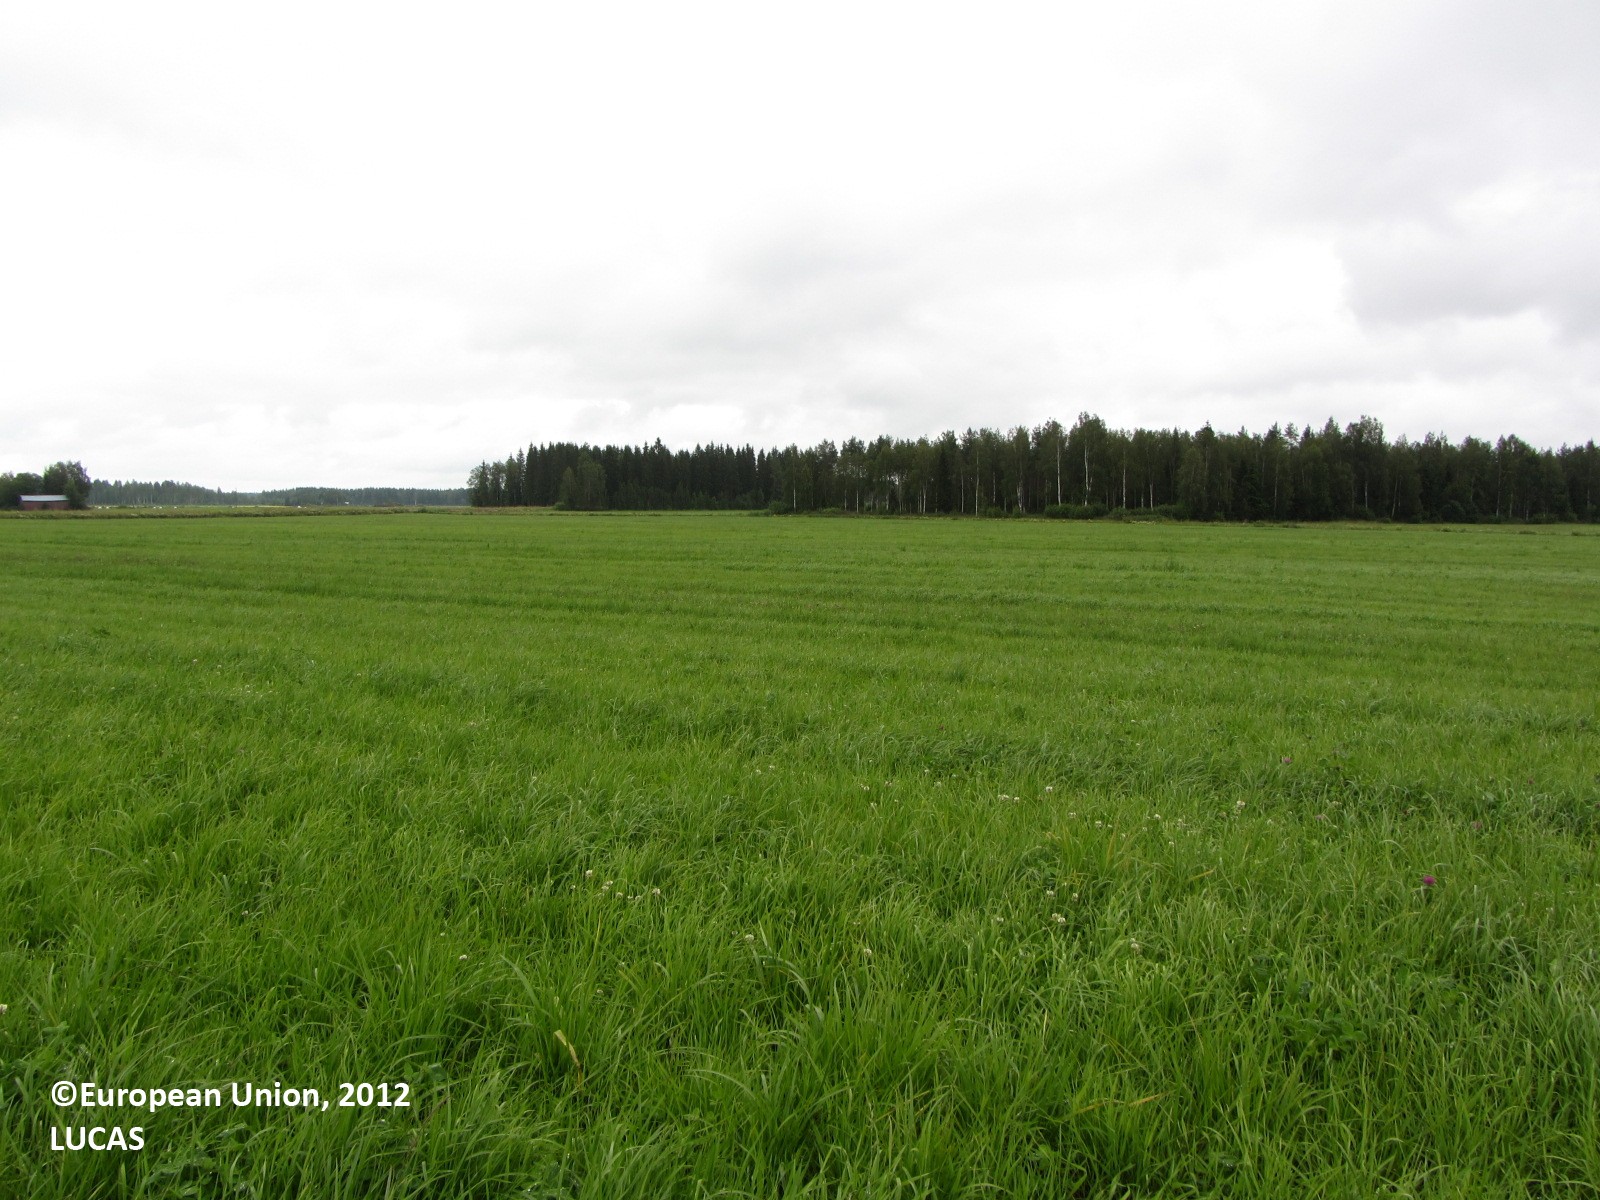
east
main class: Cropland
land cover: Temporary grasslands
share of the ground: > 75 %
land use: Agriculture (excluding fallow land and kitchen gardens)
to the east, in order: Temporary grasslands
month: July
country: FI
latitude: 63.9219
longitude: 24.7815
